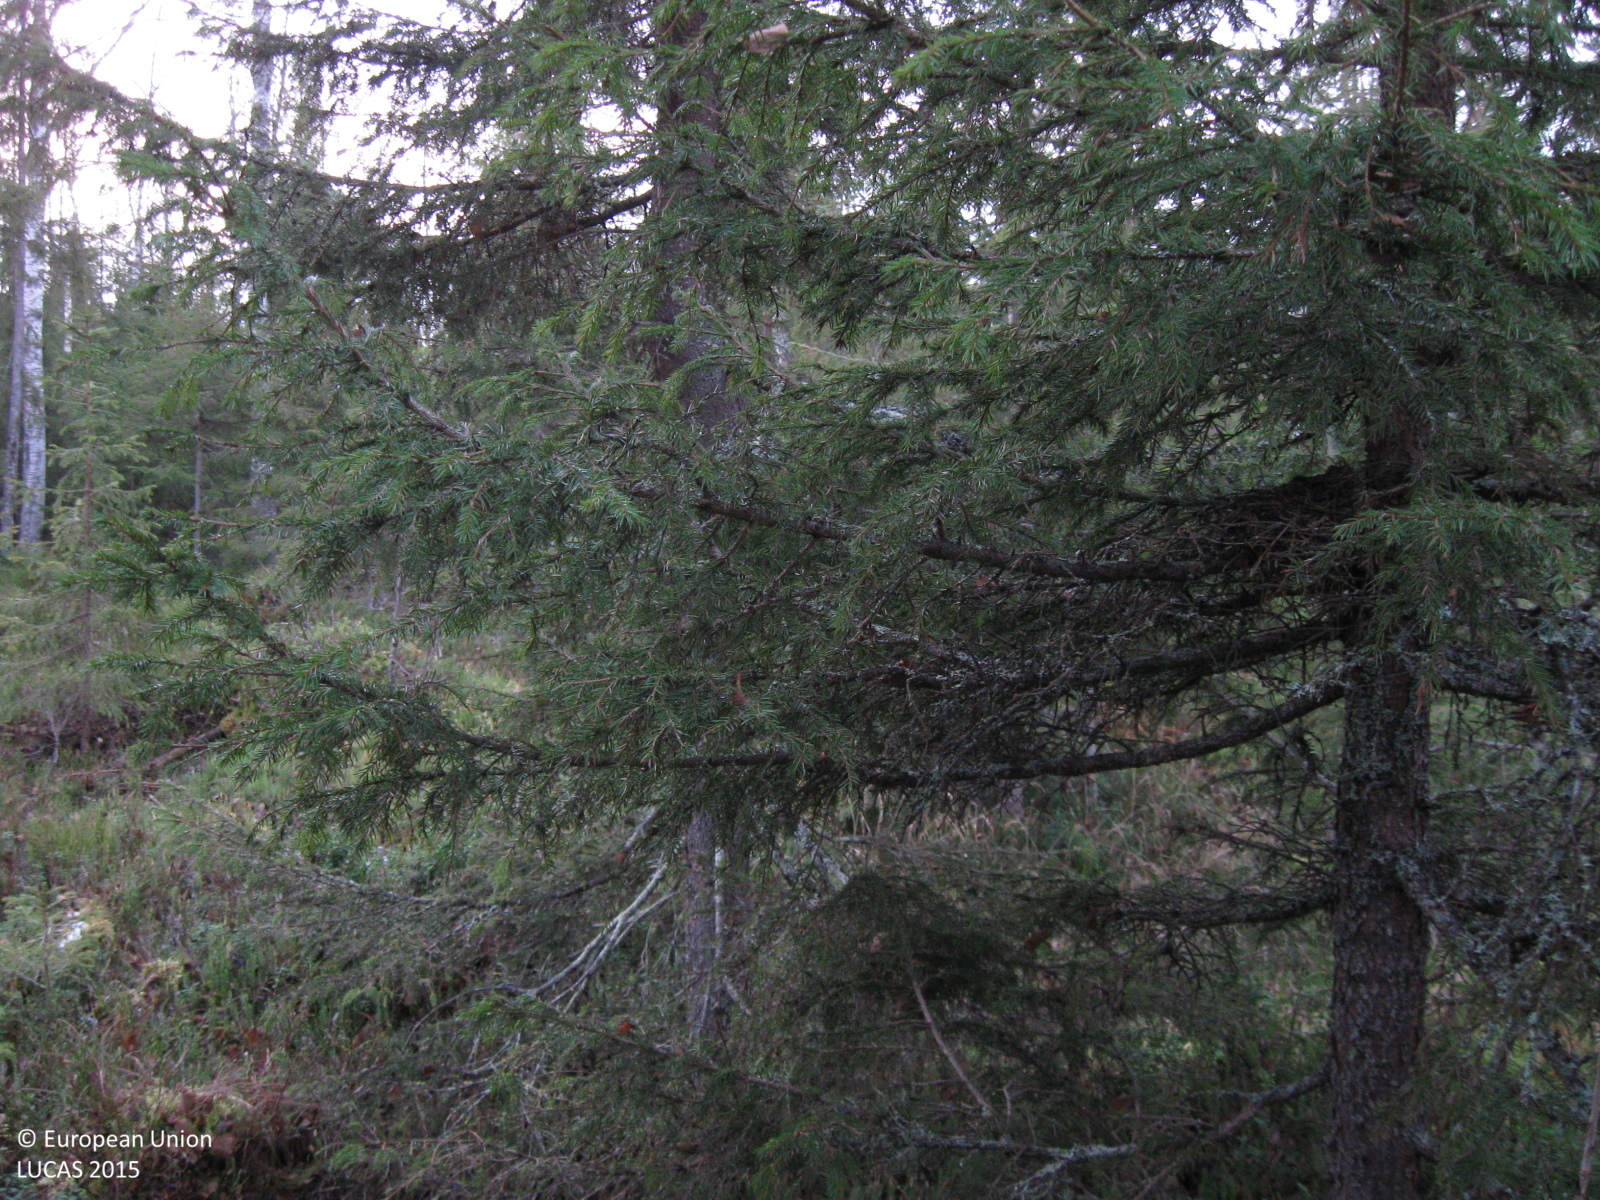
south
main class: Woodland
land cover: Spruce dominated mixed woodland
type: boreal forest
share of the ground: 50 - 75 %
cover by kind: coniferous forest trees 50 %, broadleaved forest trees 20 %, shrubs 15 %, herbaceous plants 10 %, lichens and mosses 5 %
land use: Forestry
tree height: > 5 m
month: November
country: SE
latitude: 66.1272
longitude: 20.5675
